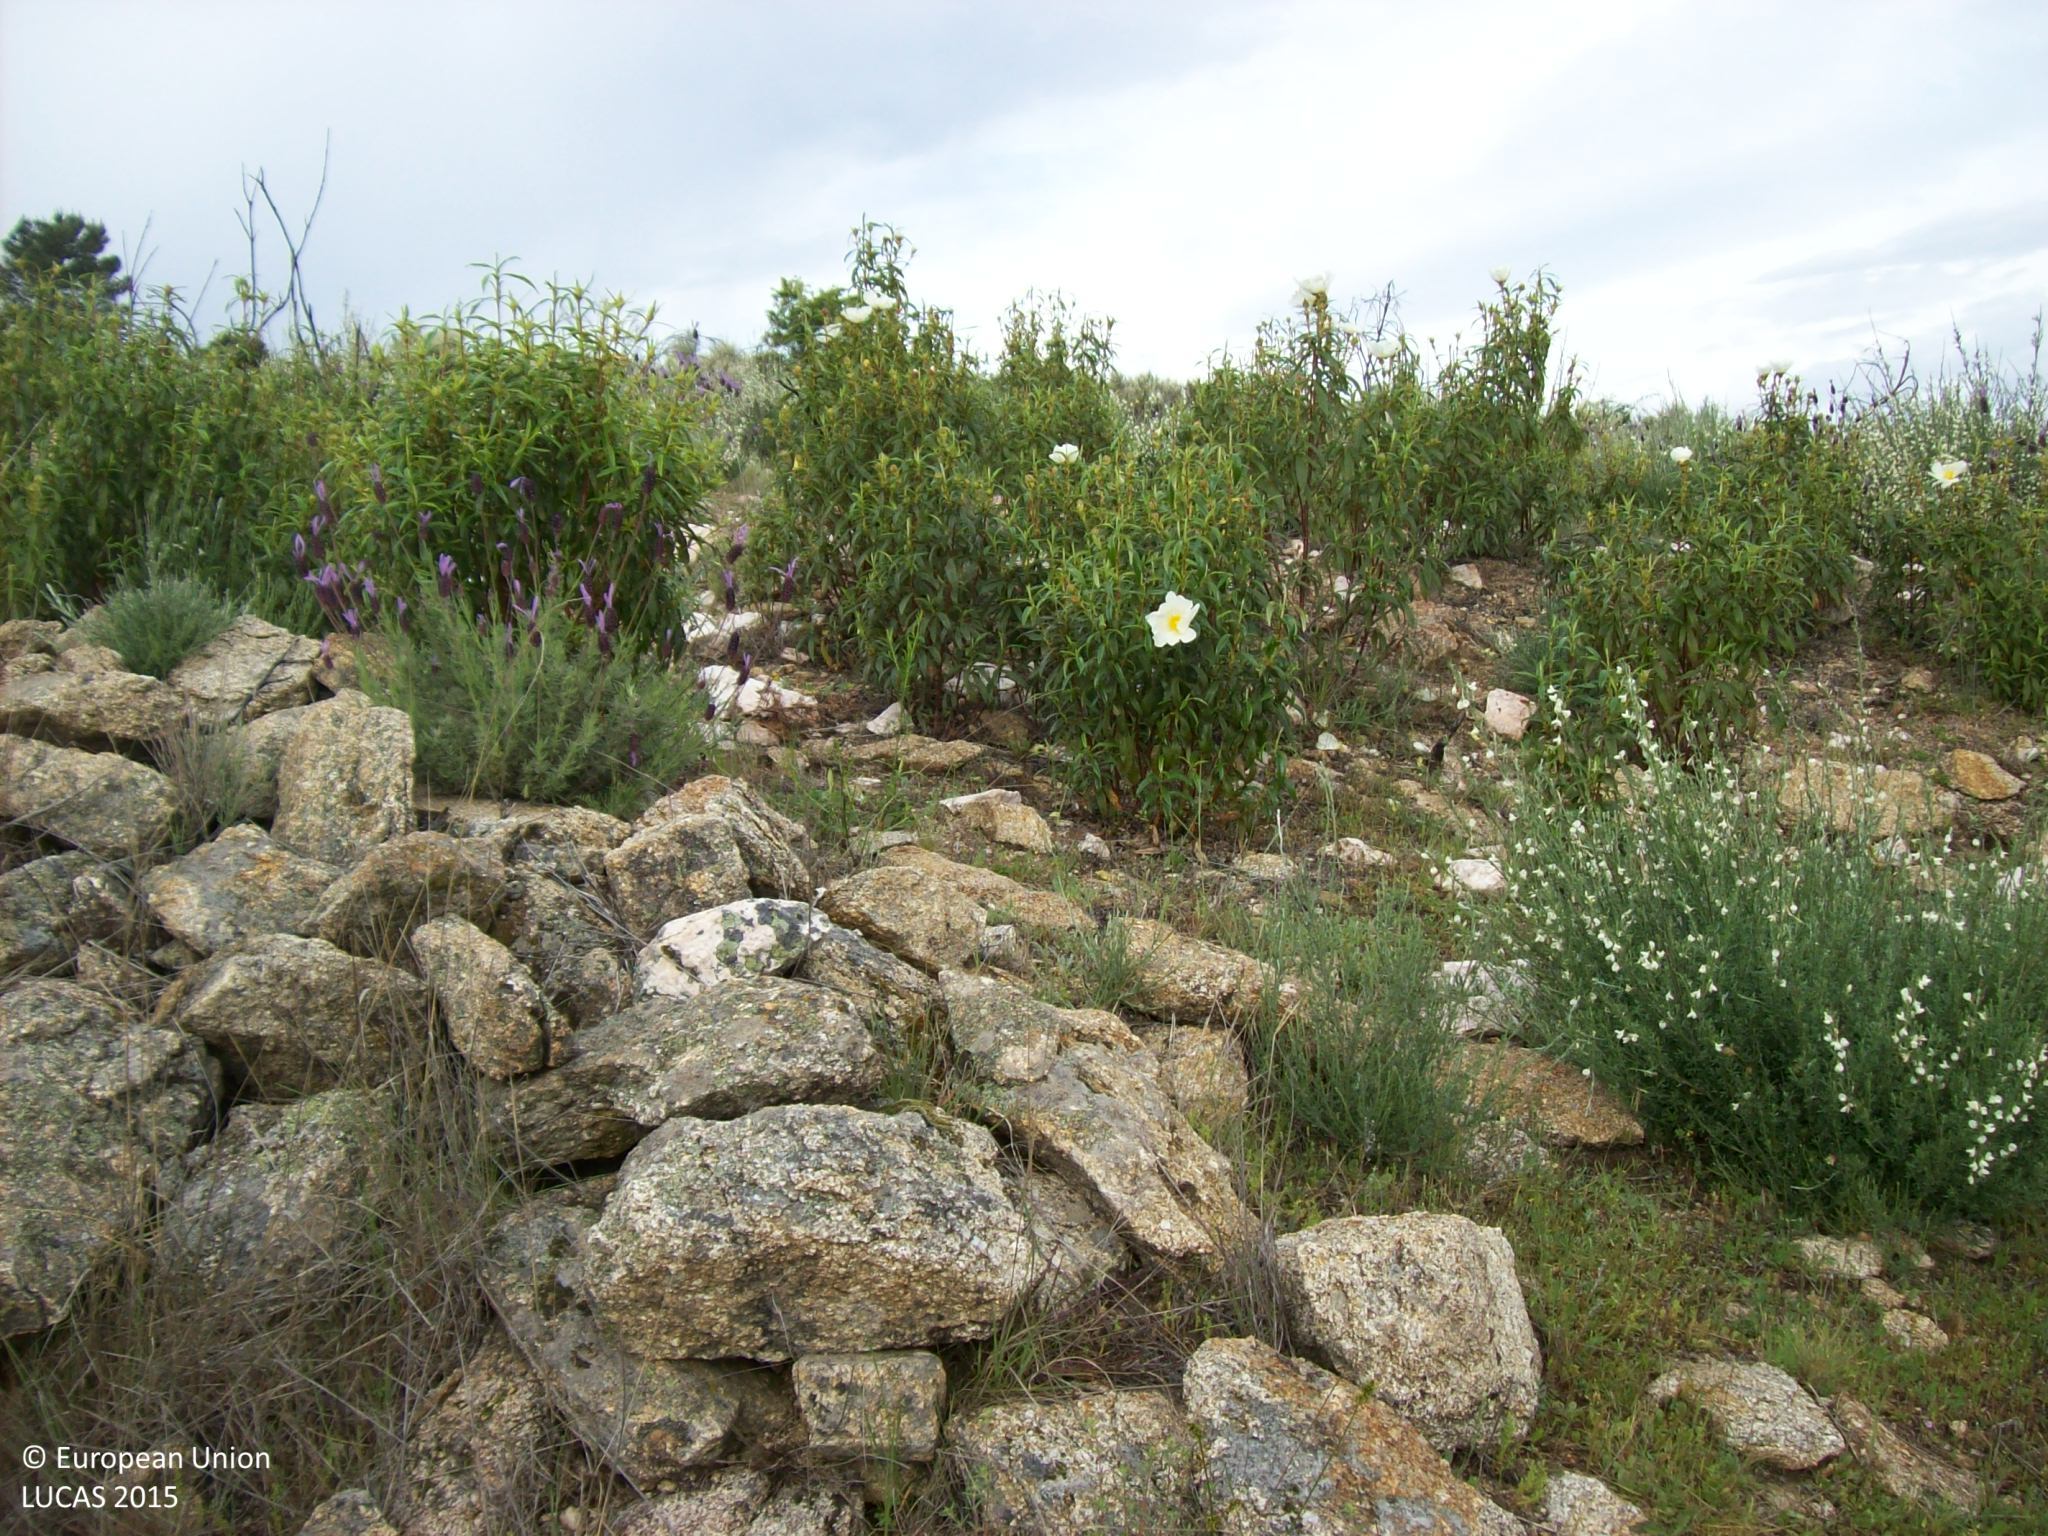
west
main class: Shrubland
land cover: Shrubland without tree cover
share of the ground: 25 - 50 %
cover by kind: herbaceous plants 45 %, shrubs 40 %, consolidated bare surface 10 %
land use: Agriculture (excluding fallow land and kitchen gardens)
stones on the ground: < 10 %
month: May
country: ES
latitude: 40.3876
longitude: -4.7902
